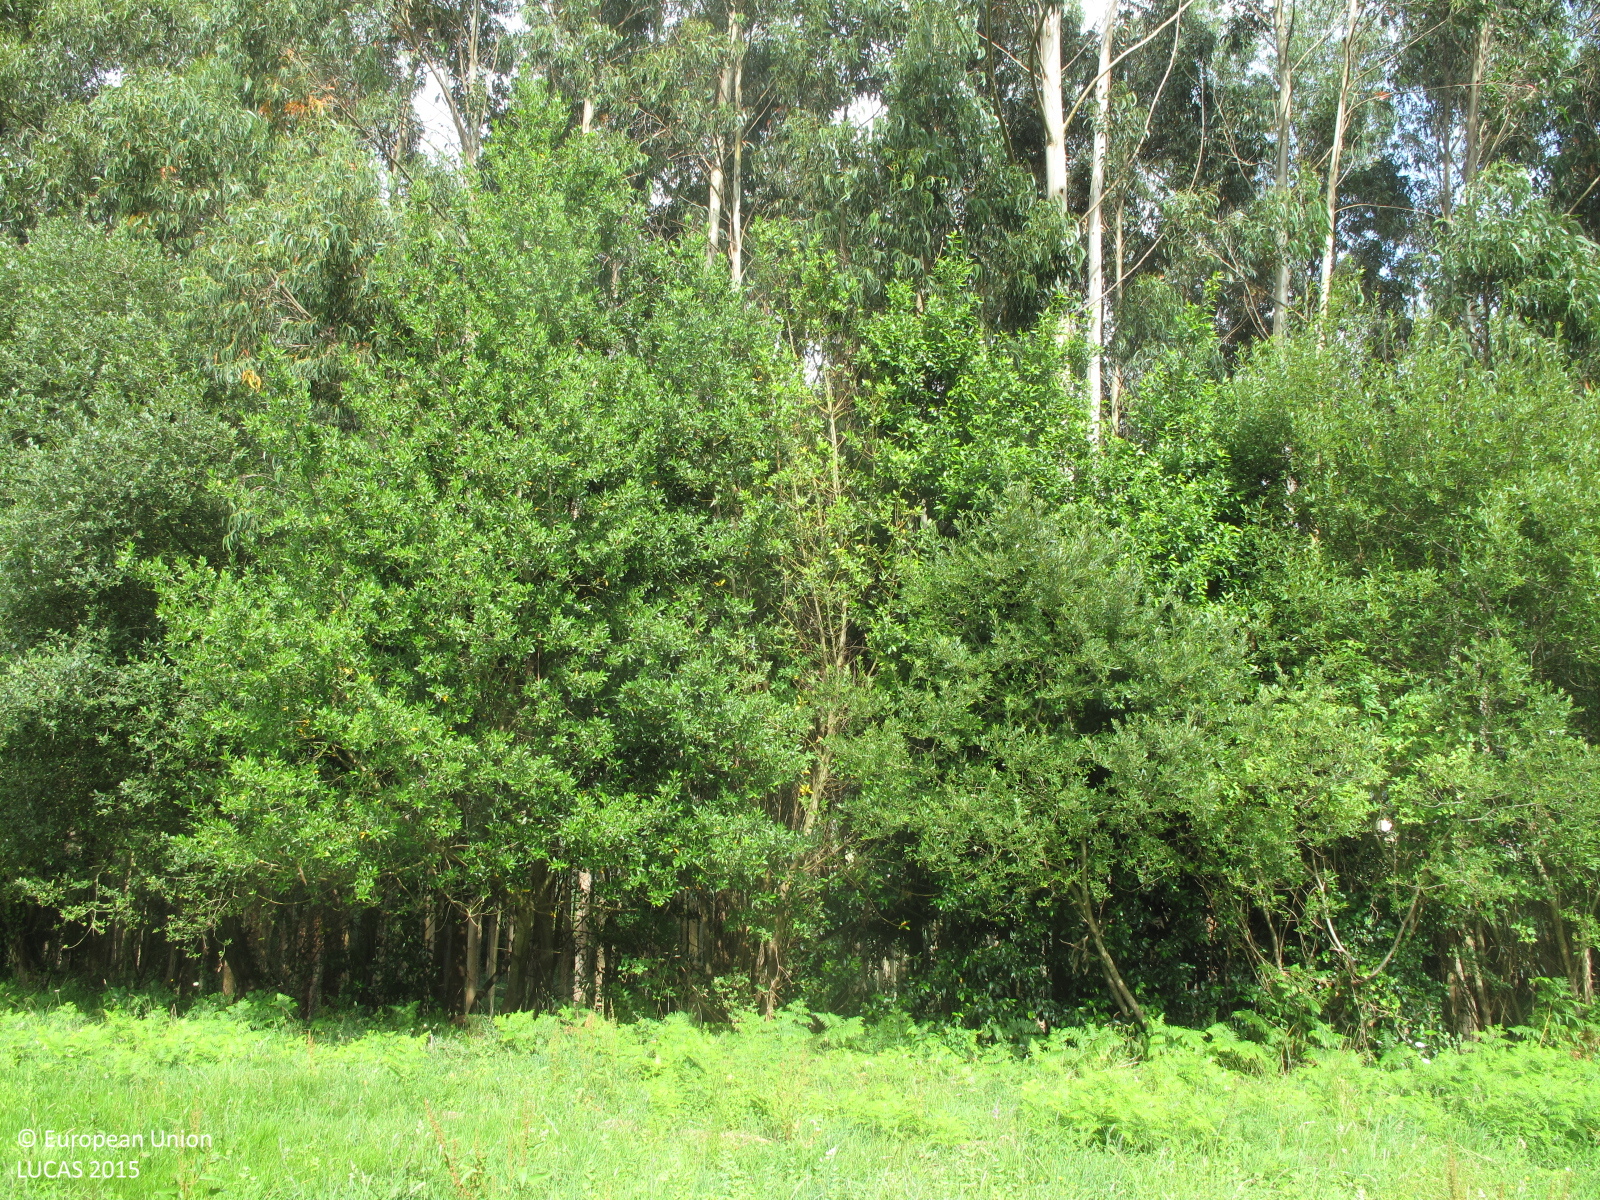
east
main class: Grassland
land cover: Grassland without tree/shrub cover
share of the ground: > 75 %
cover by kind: herbaceous plants 100 %
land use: Agriculture (excluding fallow land and kitchen gardens)
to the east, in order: Grassland without tree/shrub cover; Broadleaved woodland; Rivers and streams; Broadleaved woodland; Grassland without tree/shrub cover; Groves; Paved roads, cycling and walking lanes; Fences; Grassland without tree/shrub cover; Fences; Artificial constructions in urban areas; Fences; Grassland without tree/shrub cover
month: July
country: ES
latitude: 43.6744
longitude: -8.0471
